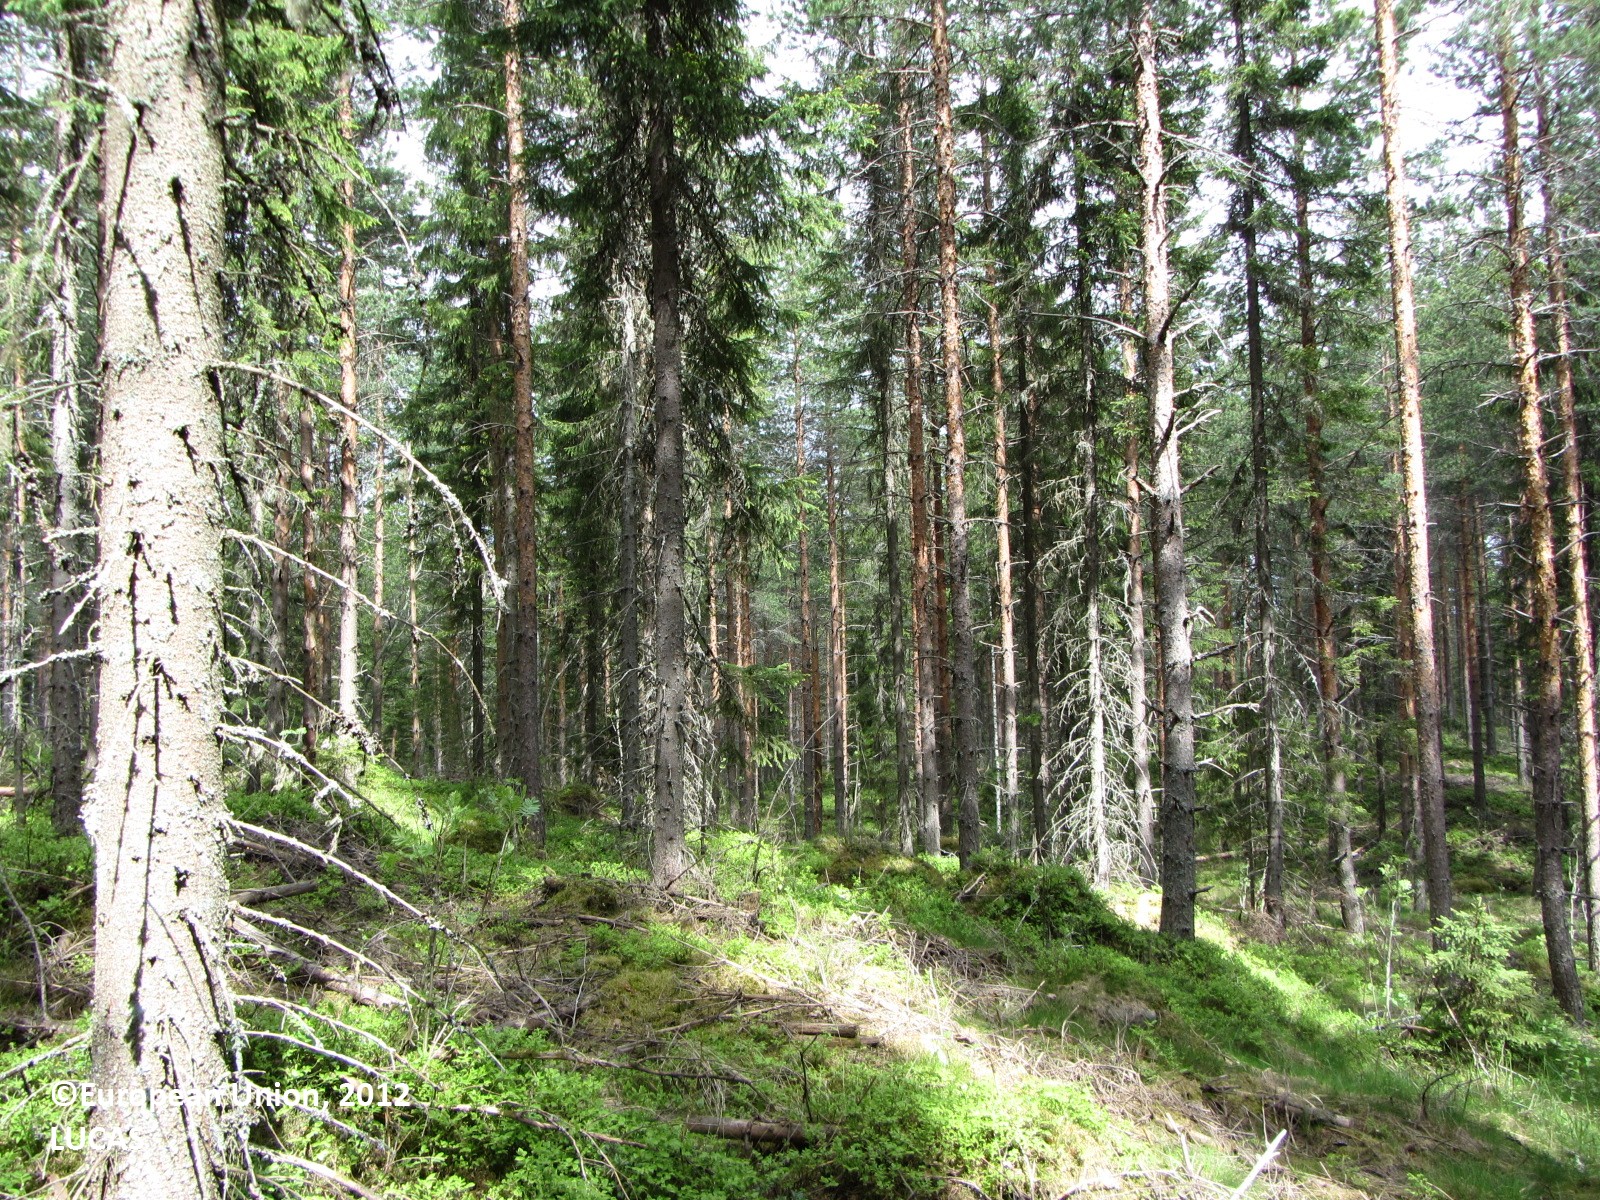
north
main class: Woodland
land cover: Pine dominated coniferous woodland
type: boreal forest
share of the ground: > 75 %
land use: Forestry
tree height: > 5 m
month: May
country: FI
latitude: 62.4636
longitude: 25.5270
